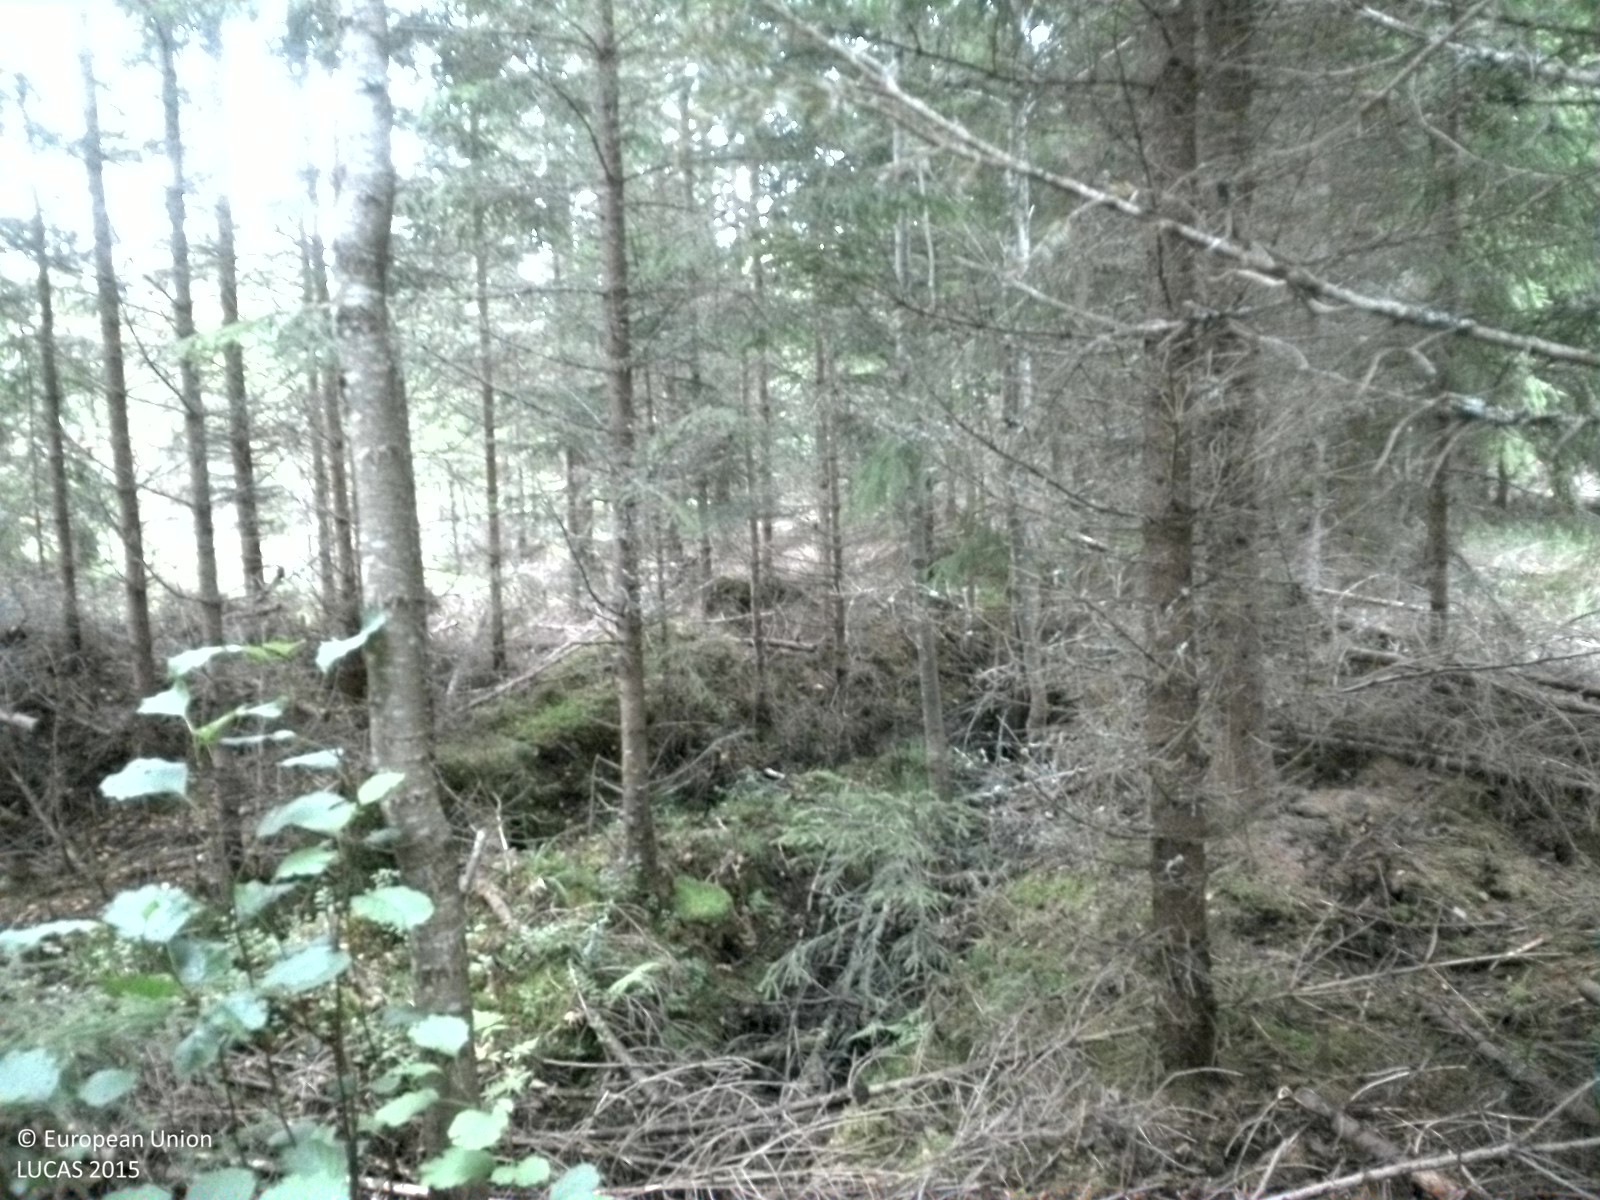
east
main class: Woodland
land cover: Spruce dominated coniferous woodland
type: boreal forest
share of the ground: 50 - 75 %
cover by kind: coniferous forest trees 70 %, lichens and mosses 20 %, broadleaved forest trees 5 %, herbaceous plants 5 %
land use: Forestry
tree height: < 5 m
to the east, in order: Spruce dominated coniferous woodland; Spruce dominated mixed woodland; Other mixed woodland; Spruce dominated coniferous woodland; Paved roads, cycling and walking lanes; Spruce dominated coniferous woodland; Spruce dominated mixed woodland; Ditches and canals; Spruce dominated coniferous woodland
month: August
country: SE
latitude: 59.0097
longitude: 15.4775
